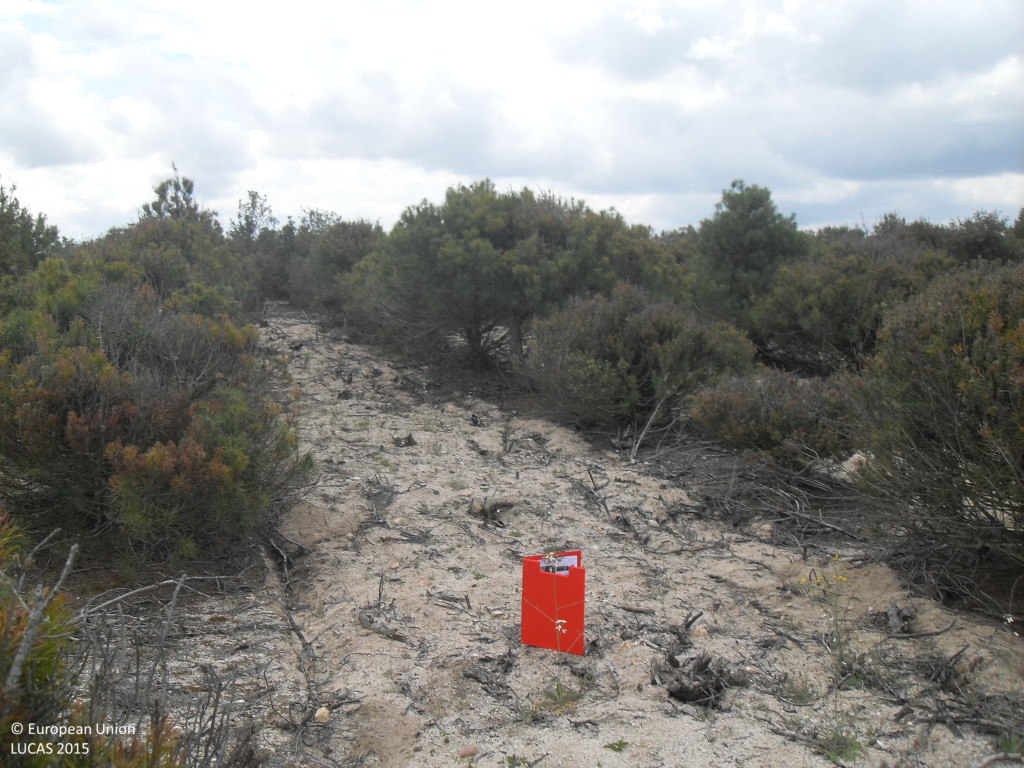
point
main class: Woodland
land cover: Pine dominated coniferous woodland
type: coniferous forest of the mediterranean region
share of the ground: > 75 %
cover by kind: coniferous forest trees 90 %, broadleaved forest trees 10 %
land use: Forestry
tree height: < 5 m
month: April
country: ES
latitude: 40.7692
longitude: -5.2911
